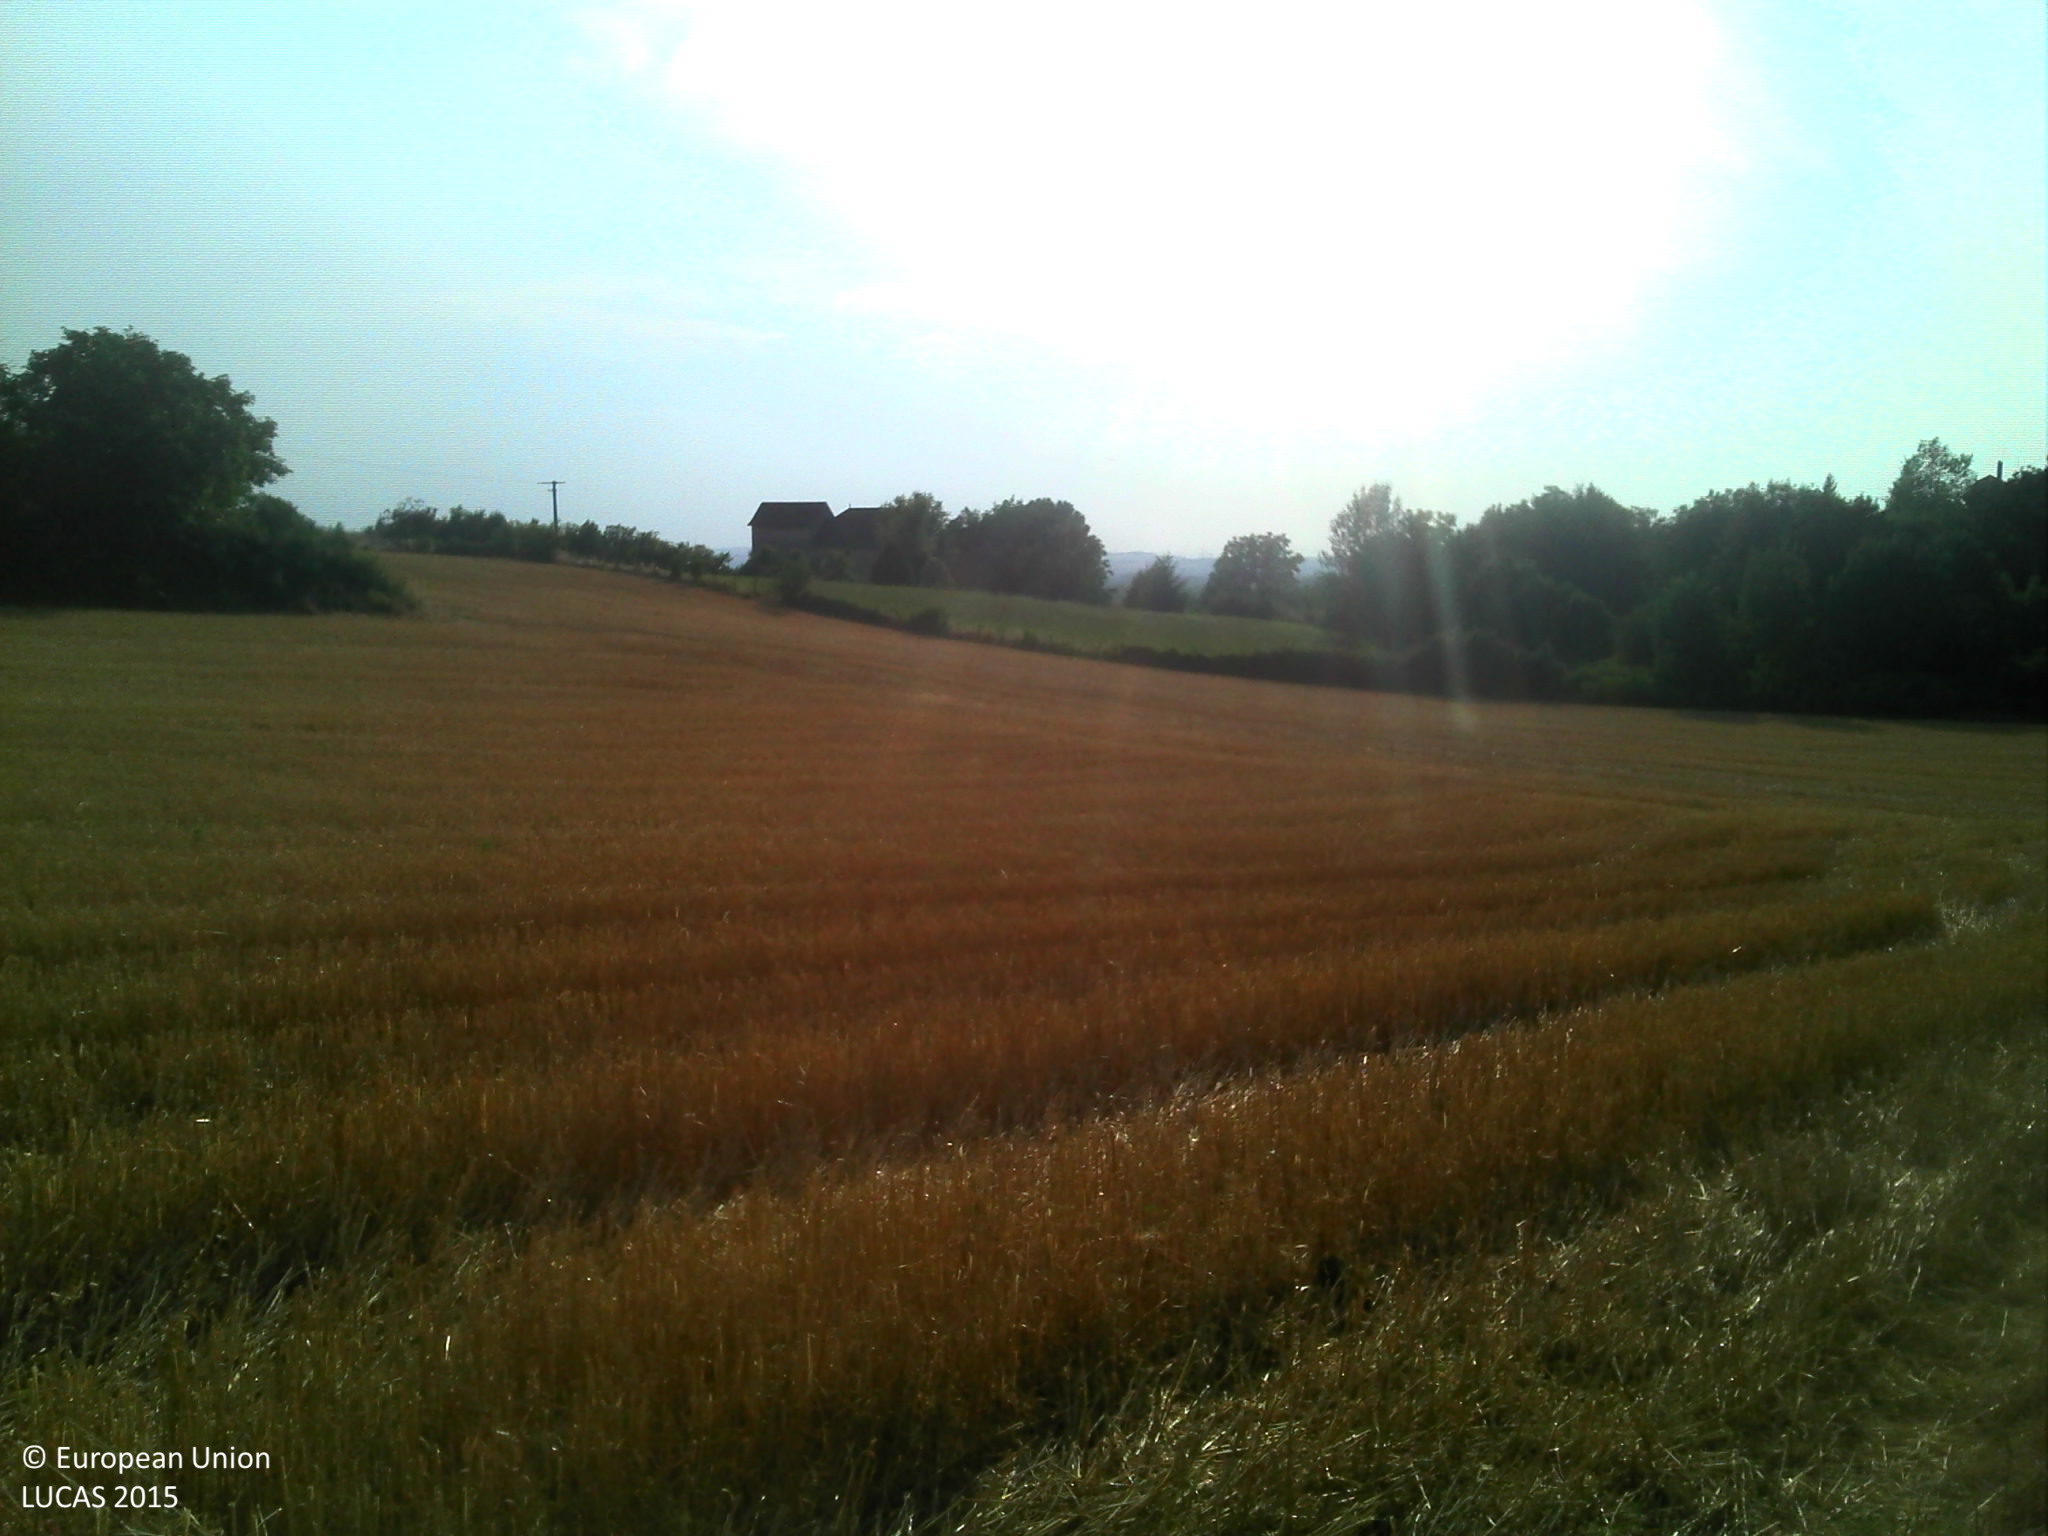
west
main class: Grassland
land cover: Grassland with sparse tree/shrub cover
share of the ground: > 75 %
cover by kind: herbaceous plants 95 %, coniferous forest trees 5 %
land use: Residential
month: July
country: FR
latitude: 45.6476
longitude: 5.1924
